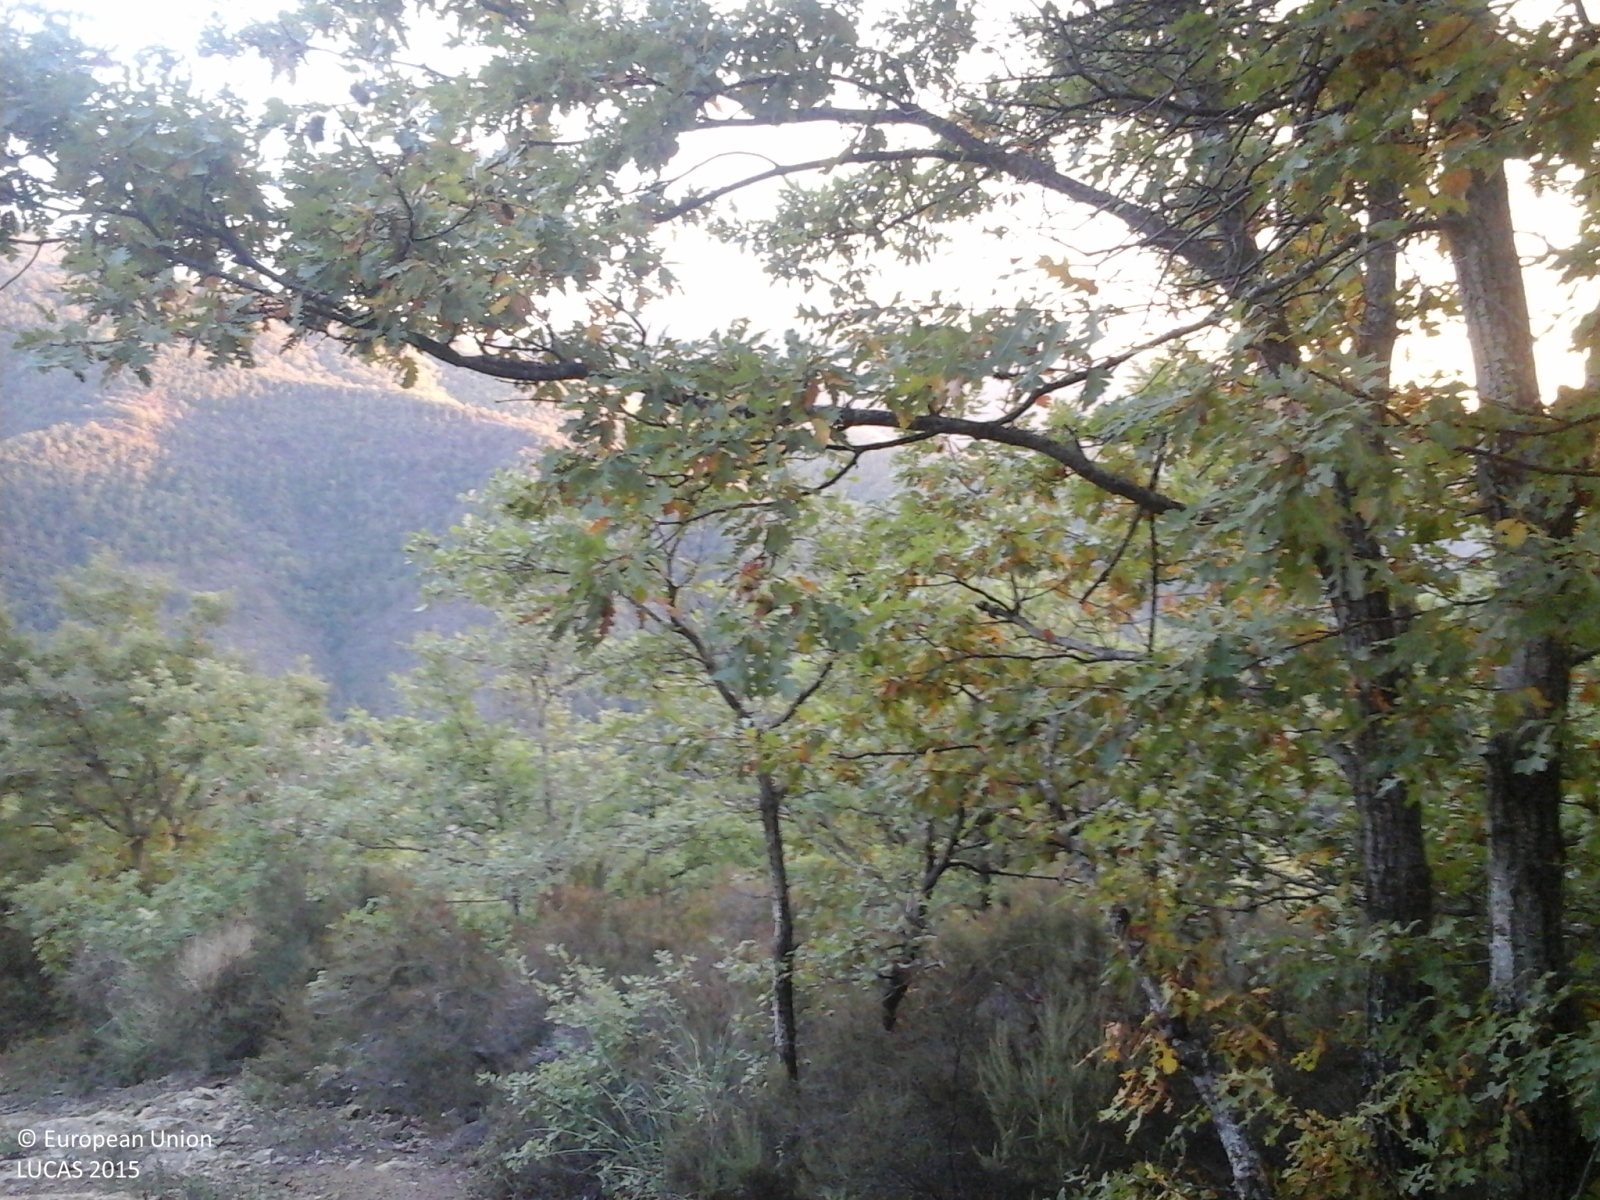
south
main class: Woodland
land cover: Broadleaved woodland
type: thermophilous deciduous forest
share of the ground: > 75 %
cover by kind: broadleaved forest trees 95 %, shrubs 5 %
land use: Semi-natural and natural areas not in use
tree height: > 5 m
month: October
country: IT
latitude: 43.3732
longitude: 12.0800
